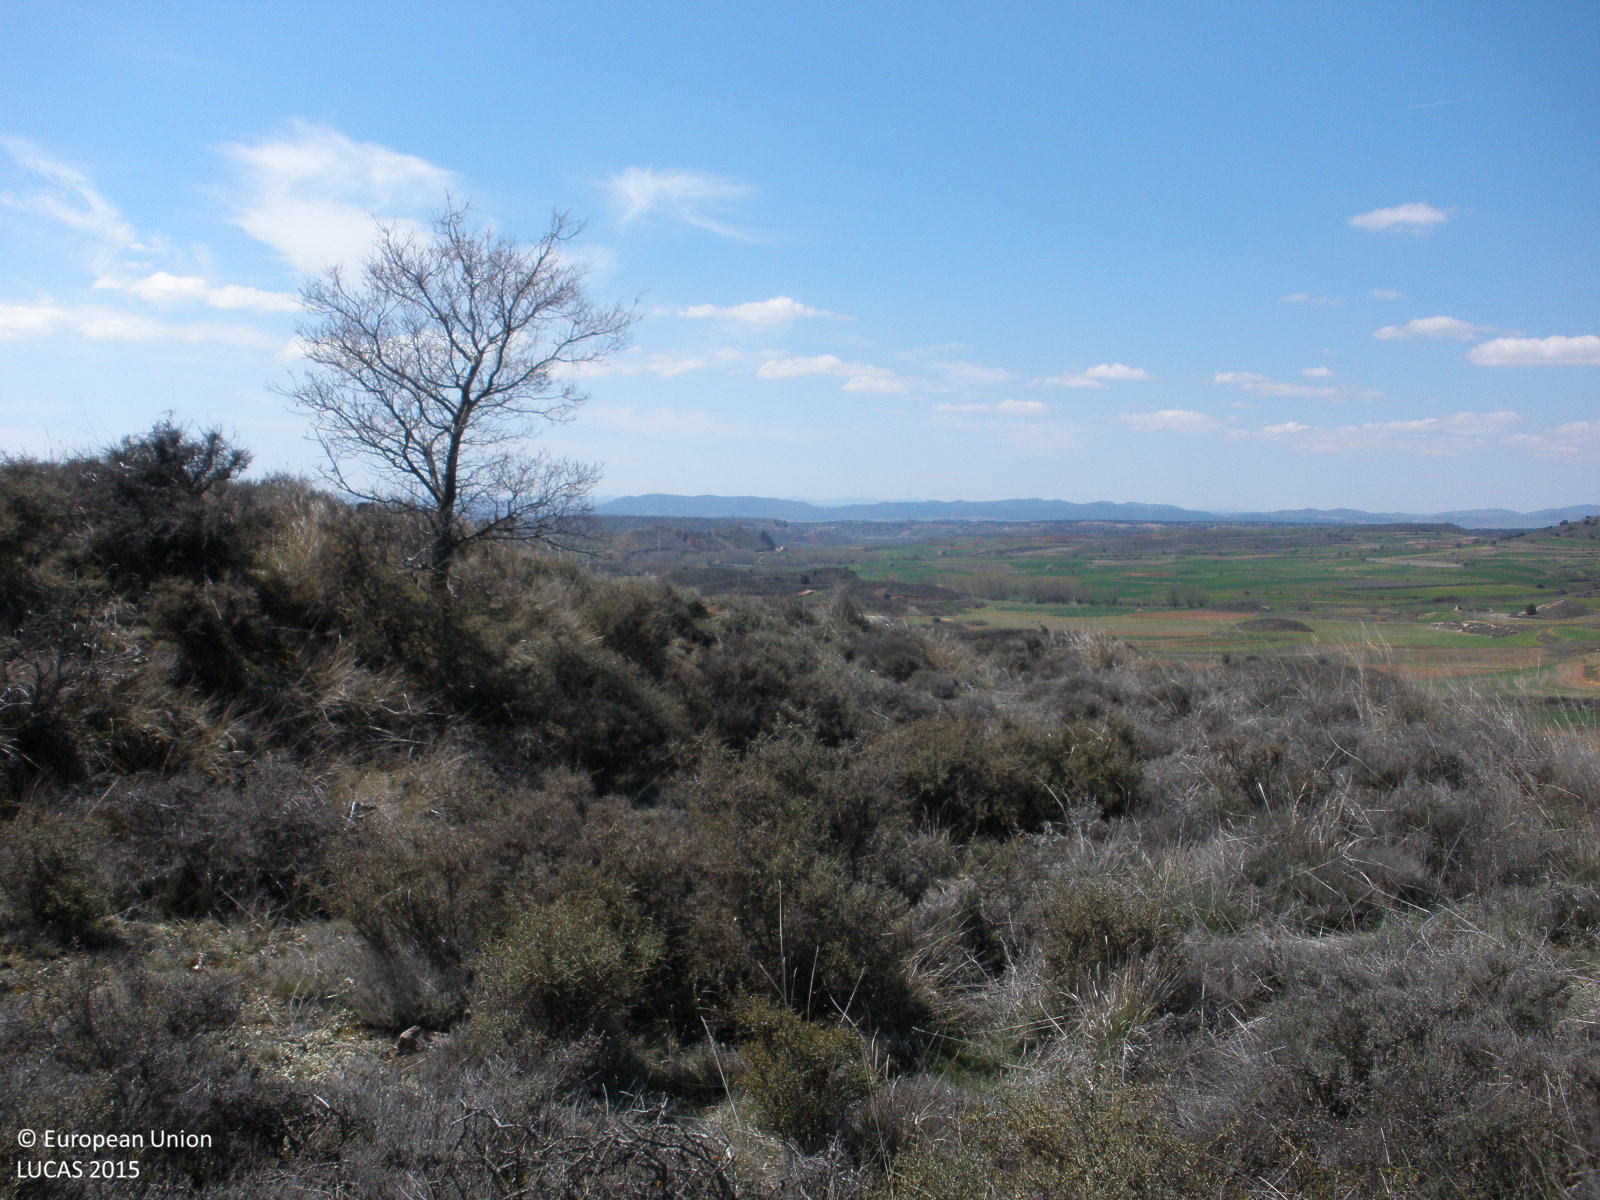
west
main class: Shrubland
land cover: Shrubland without tree cover
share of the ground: > 75 %
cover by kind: shrubs 70 %, herbaceous plants 30 %
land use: Semi-natural and natural areas not in use
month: April
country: ES
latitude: 40.9434
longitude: -1.1470
